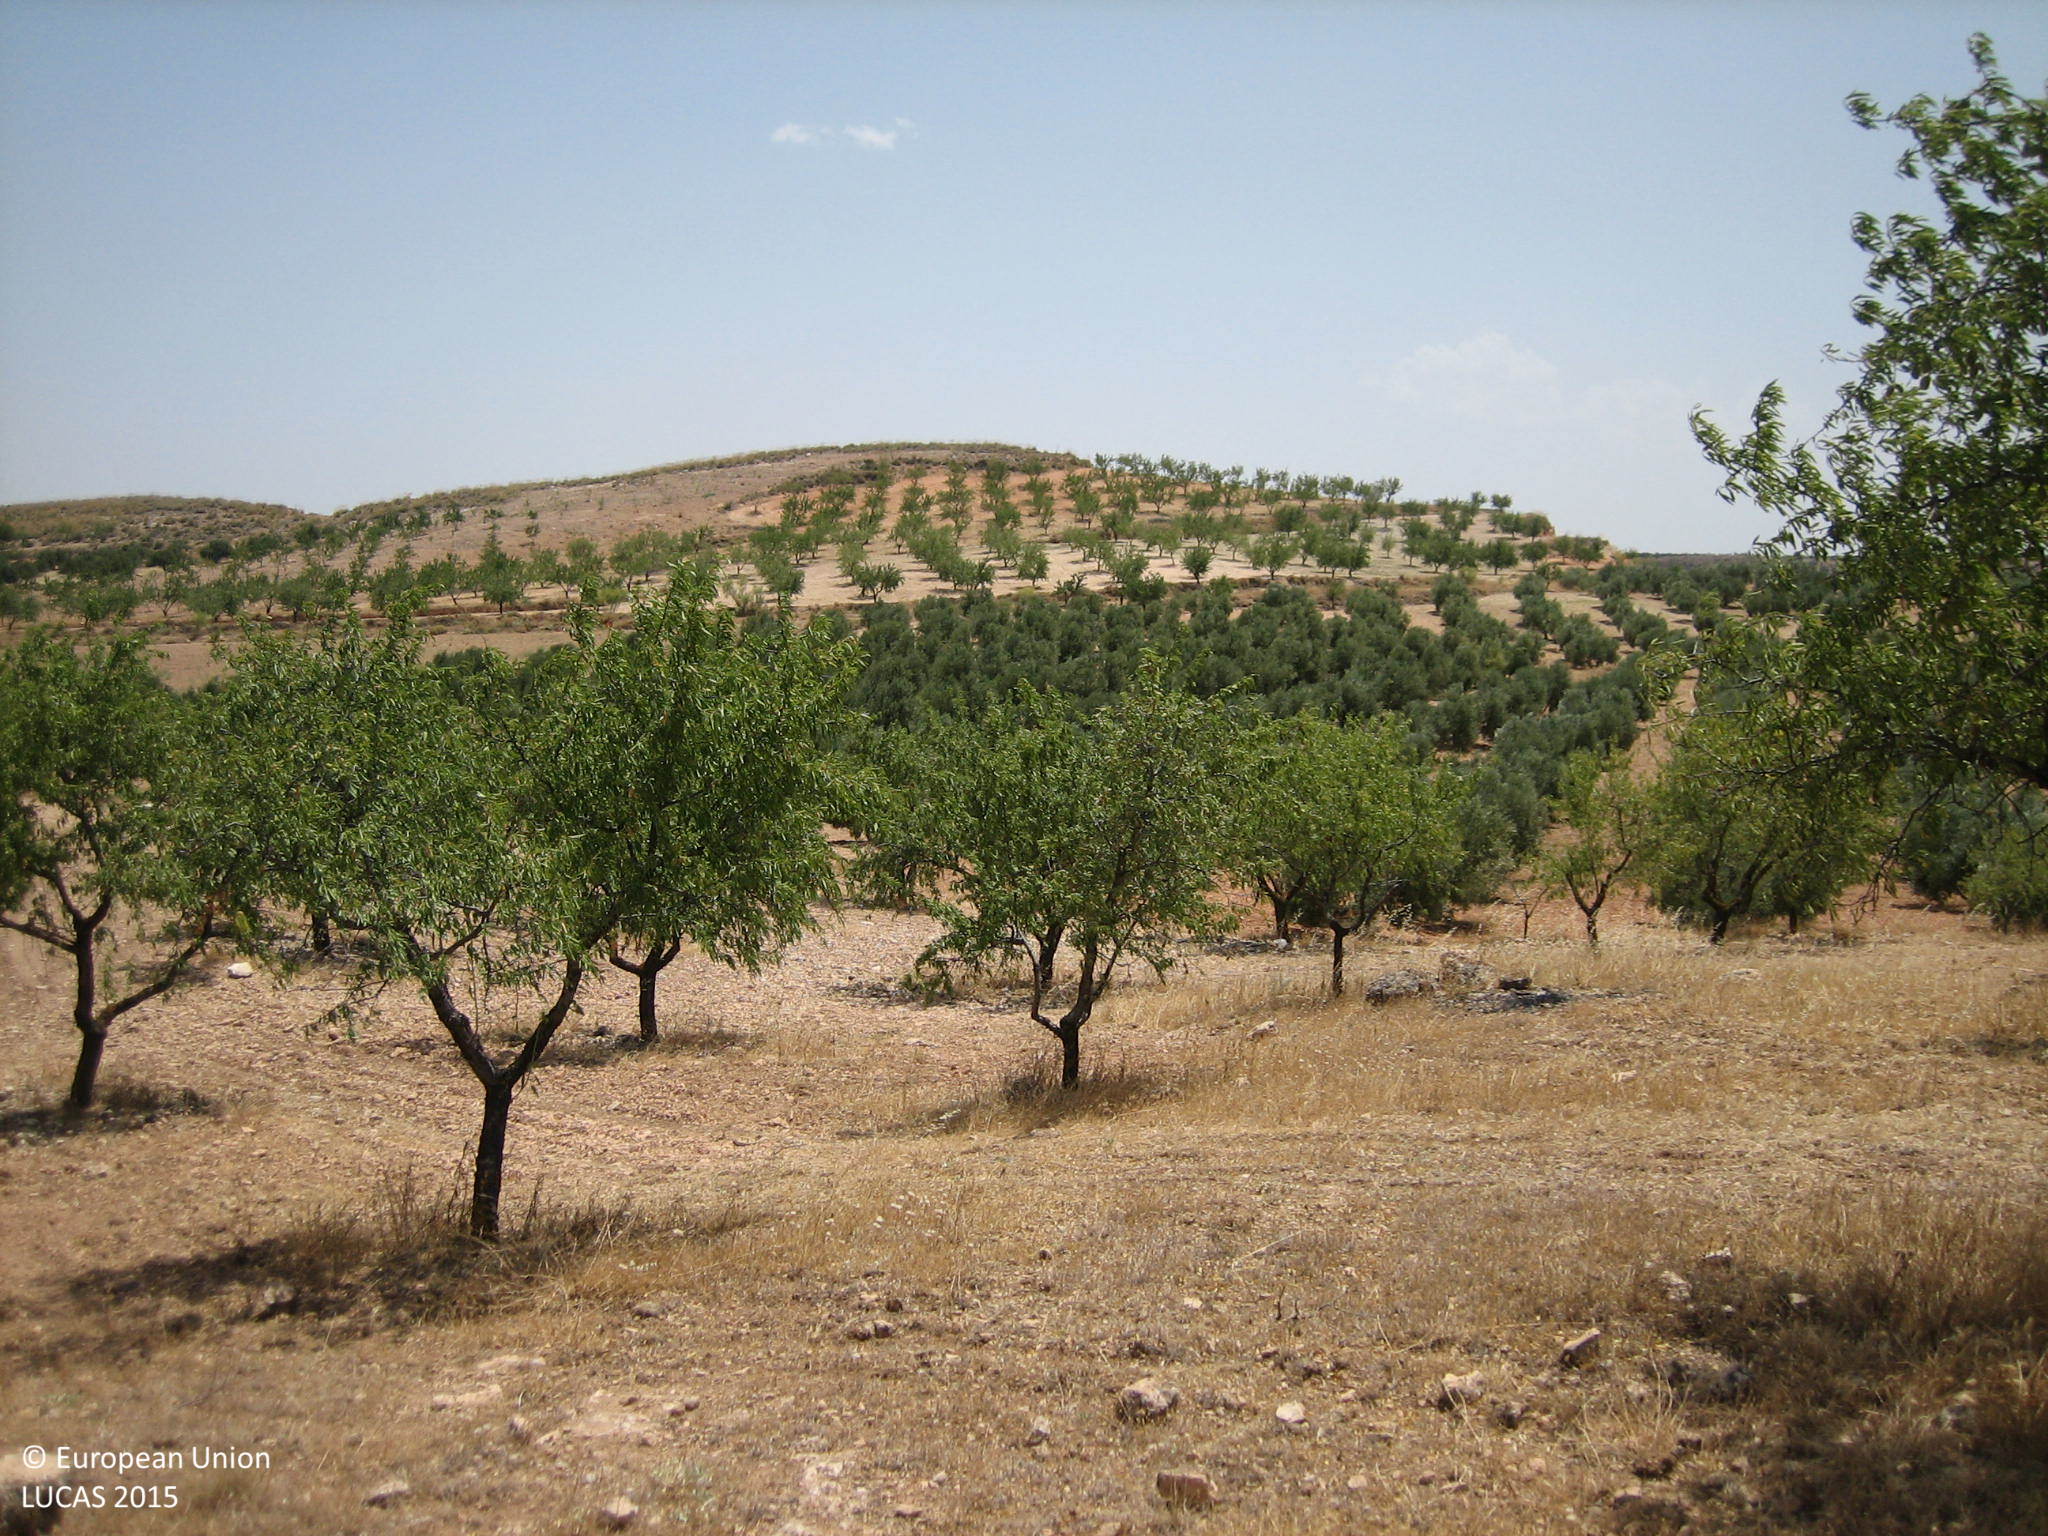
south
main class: Shrubland
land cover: Shrubland without tree cover
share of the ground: 25 - 50 %
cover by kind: herbaceous plants 60 %, shrubs 30 %, consolidated bare surface 10 %
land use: Semi-natural and natural areas not in use
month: July
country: ES
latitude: 37.6978
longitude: -2.9778
